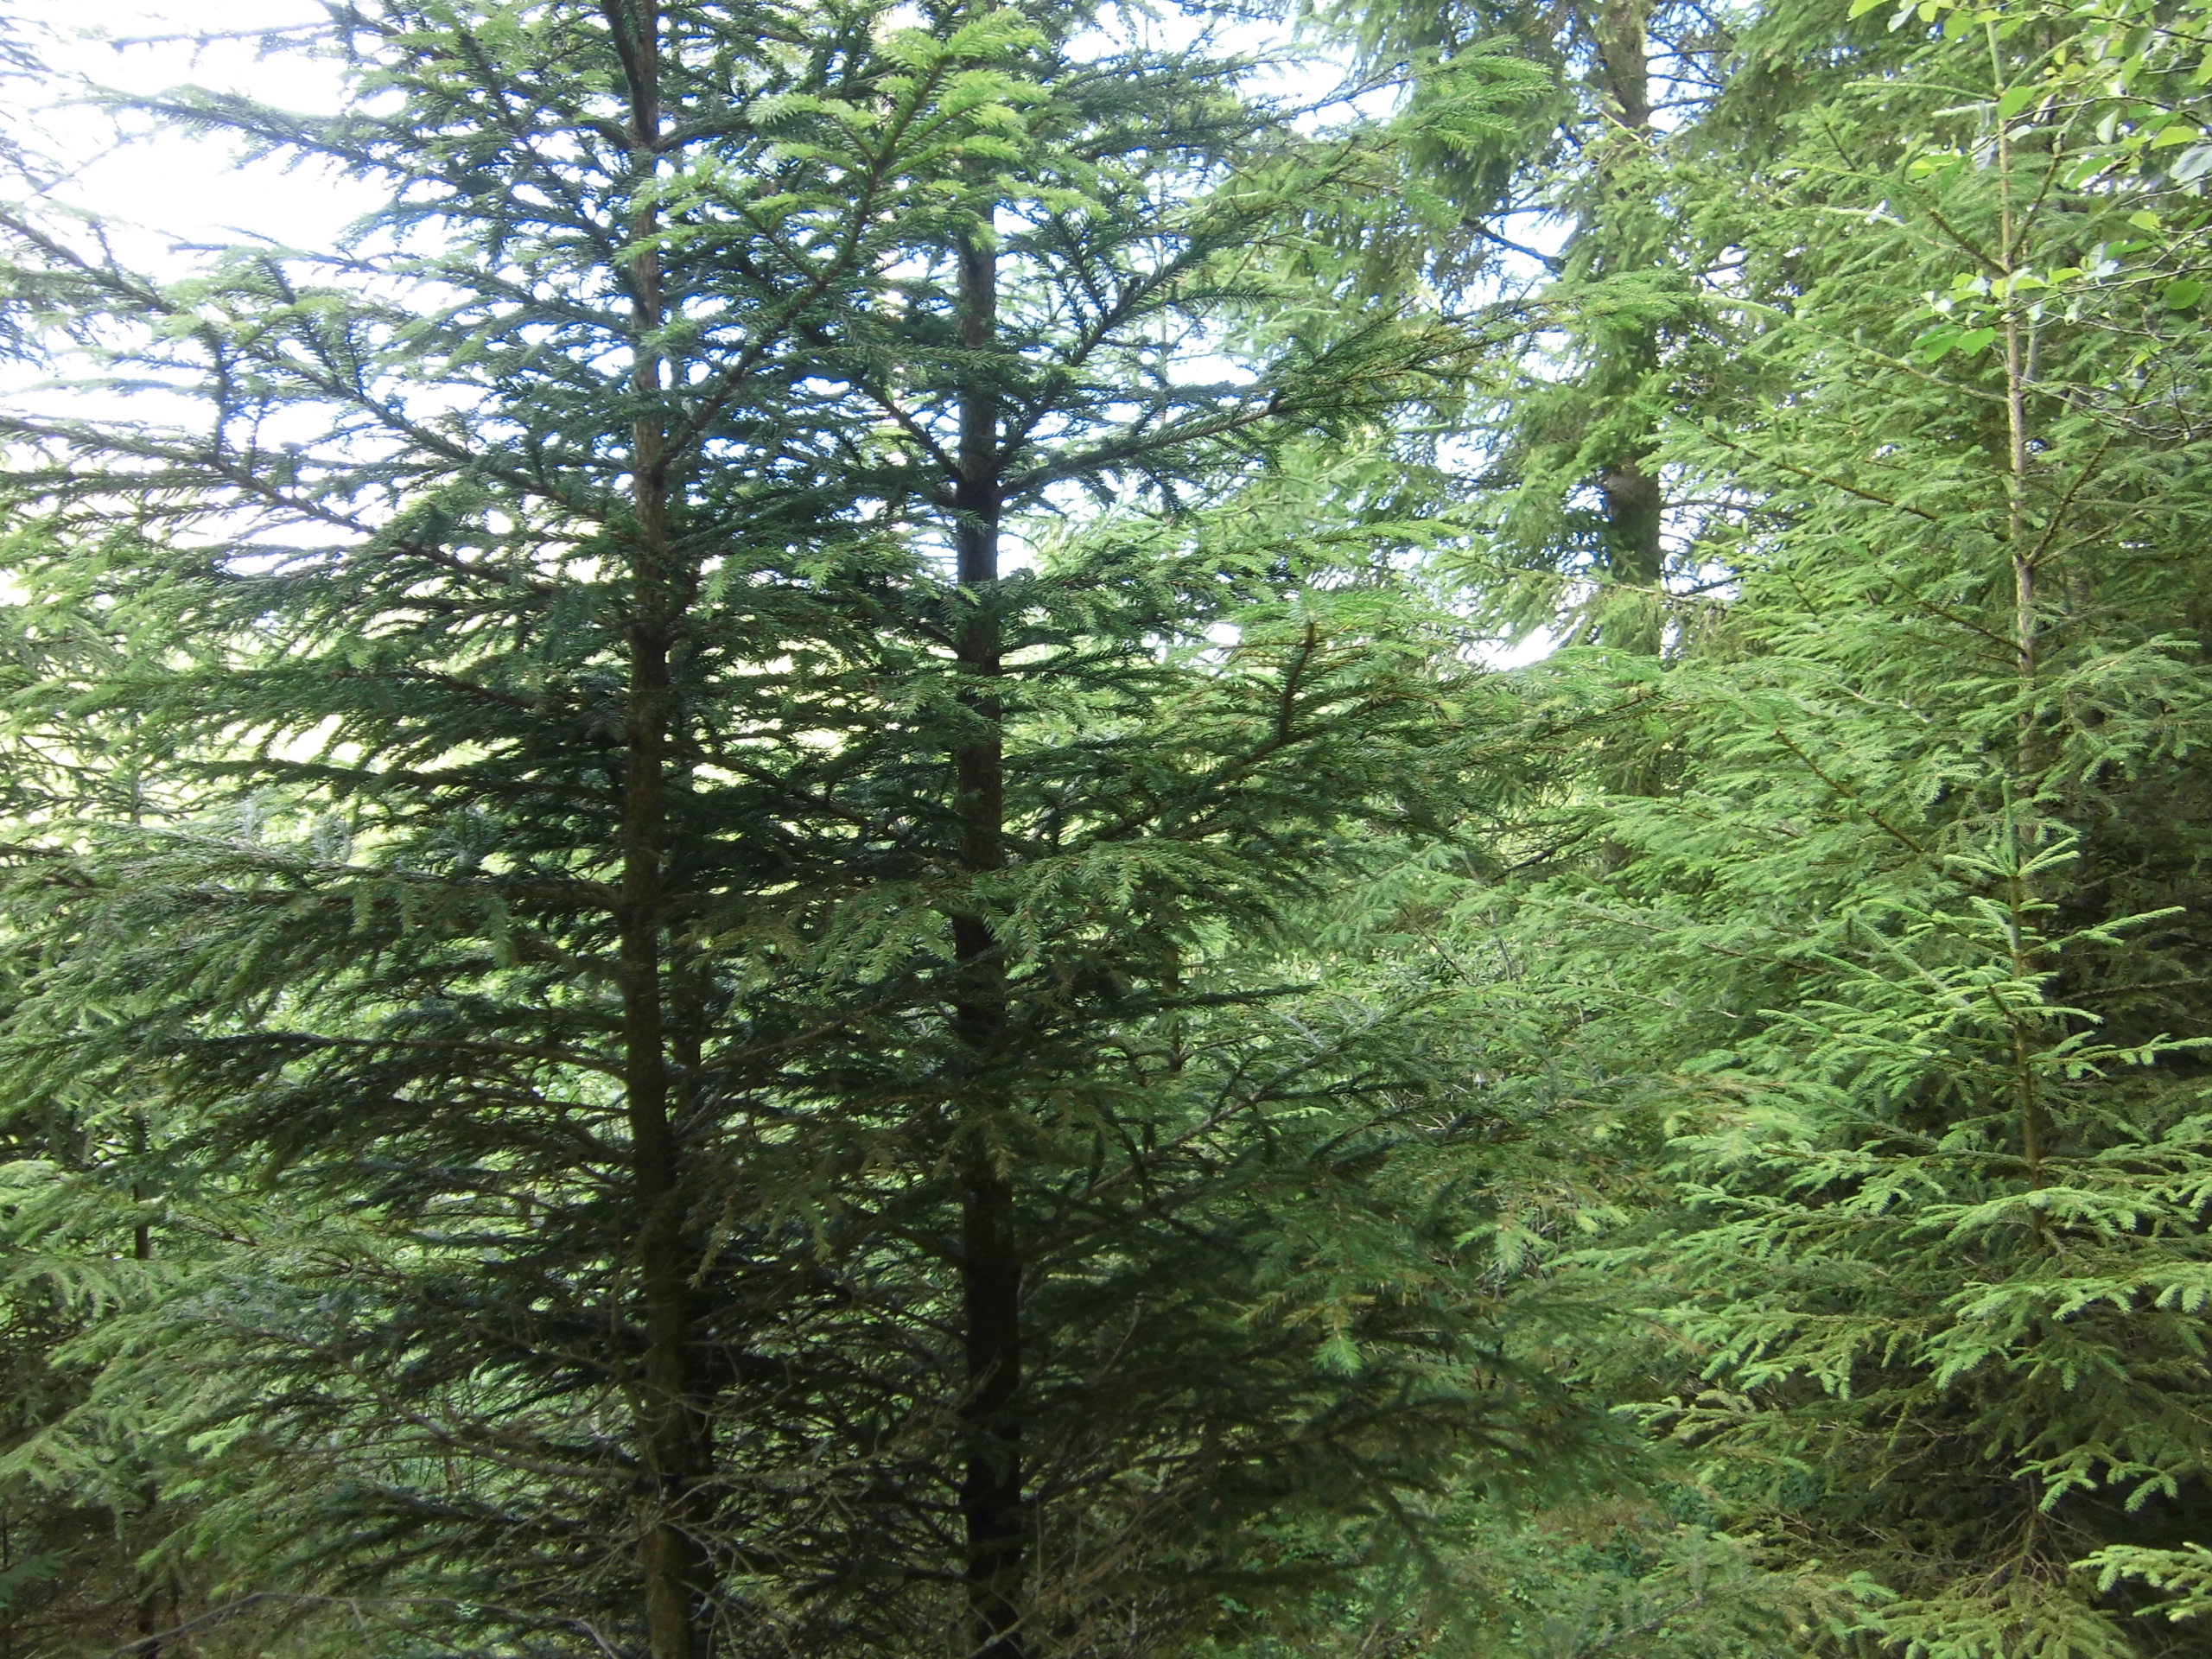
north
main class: Woodland
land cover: Spruce dominated coniferous woodland
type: boreal forest
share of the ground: 50 - 75 %
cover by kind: coniferous forest trees 55 %, herbaceous plants 15 %, lichens and mosses 15 %, shrubs 10 %, broadleaved forest trees 5 %
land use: Forestry
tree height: > 5 m
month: July
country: SE
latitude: 57.3273
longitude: 15.1620
